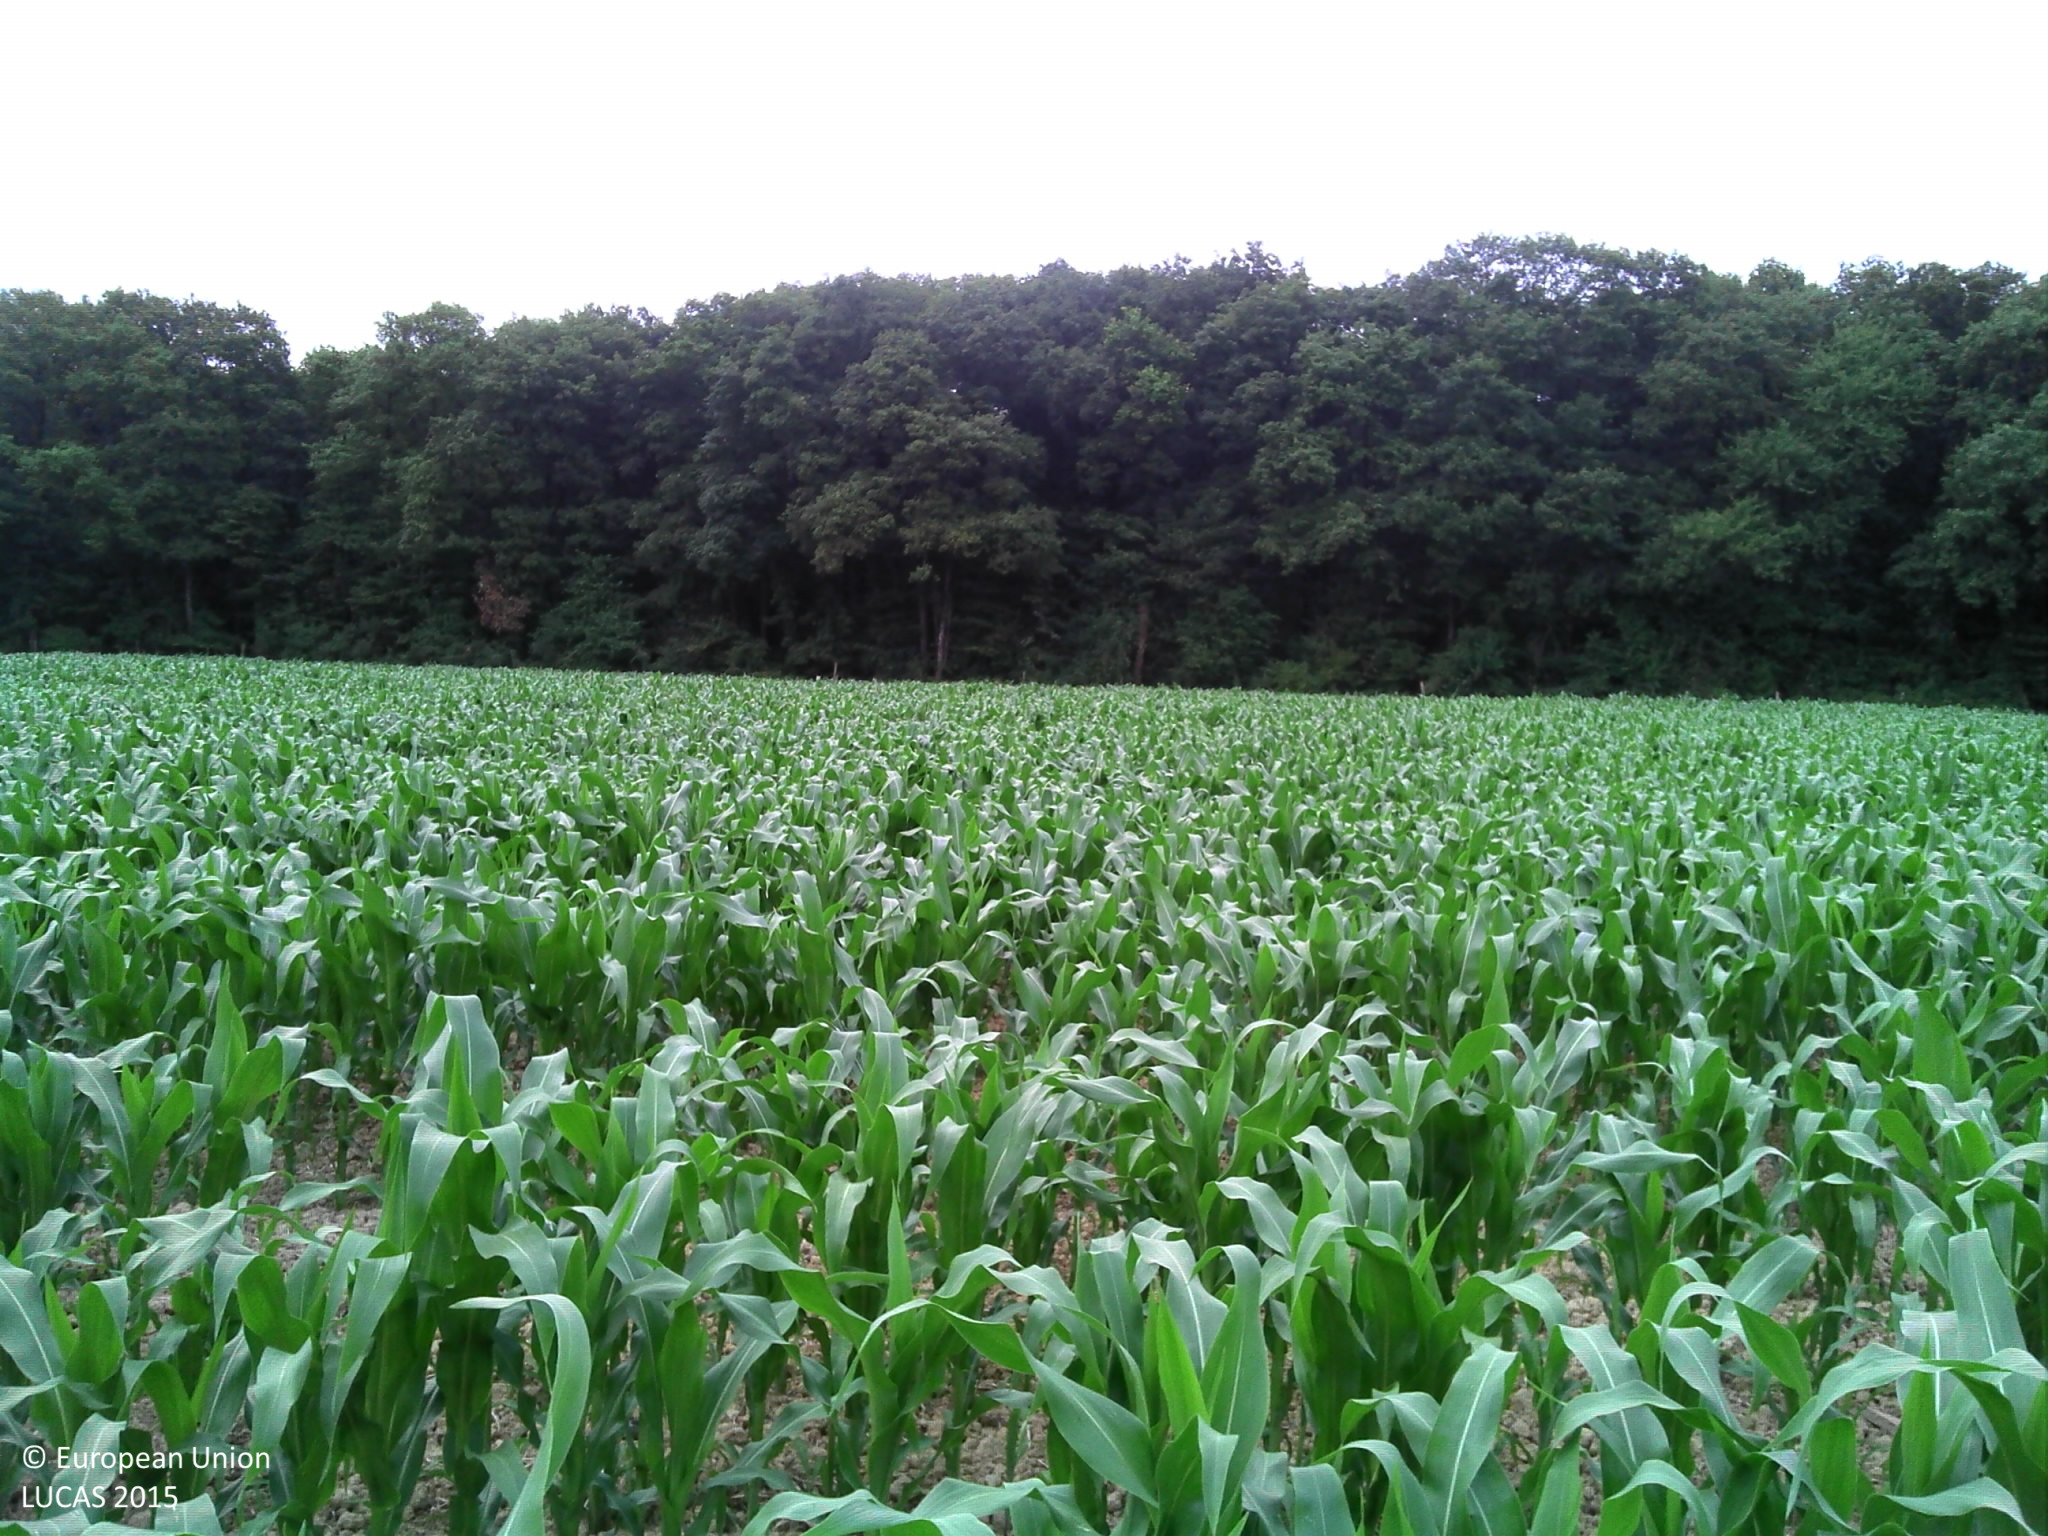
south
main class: Cropland
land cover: Maize
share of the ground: 25 - 50 %
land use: Agriculture (excluding fallow land and kitchen gardens)
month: July
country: FR
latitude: 47.8465
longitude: -1.4153
